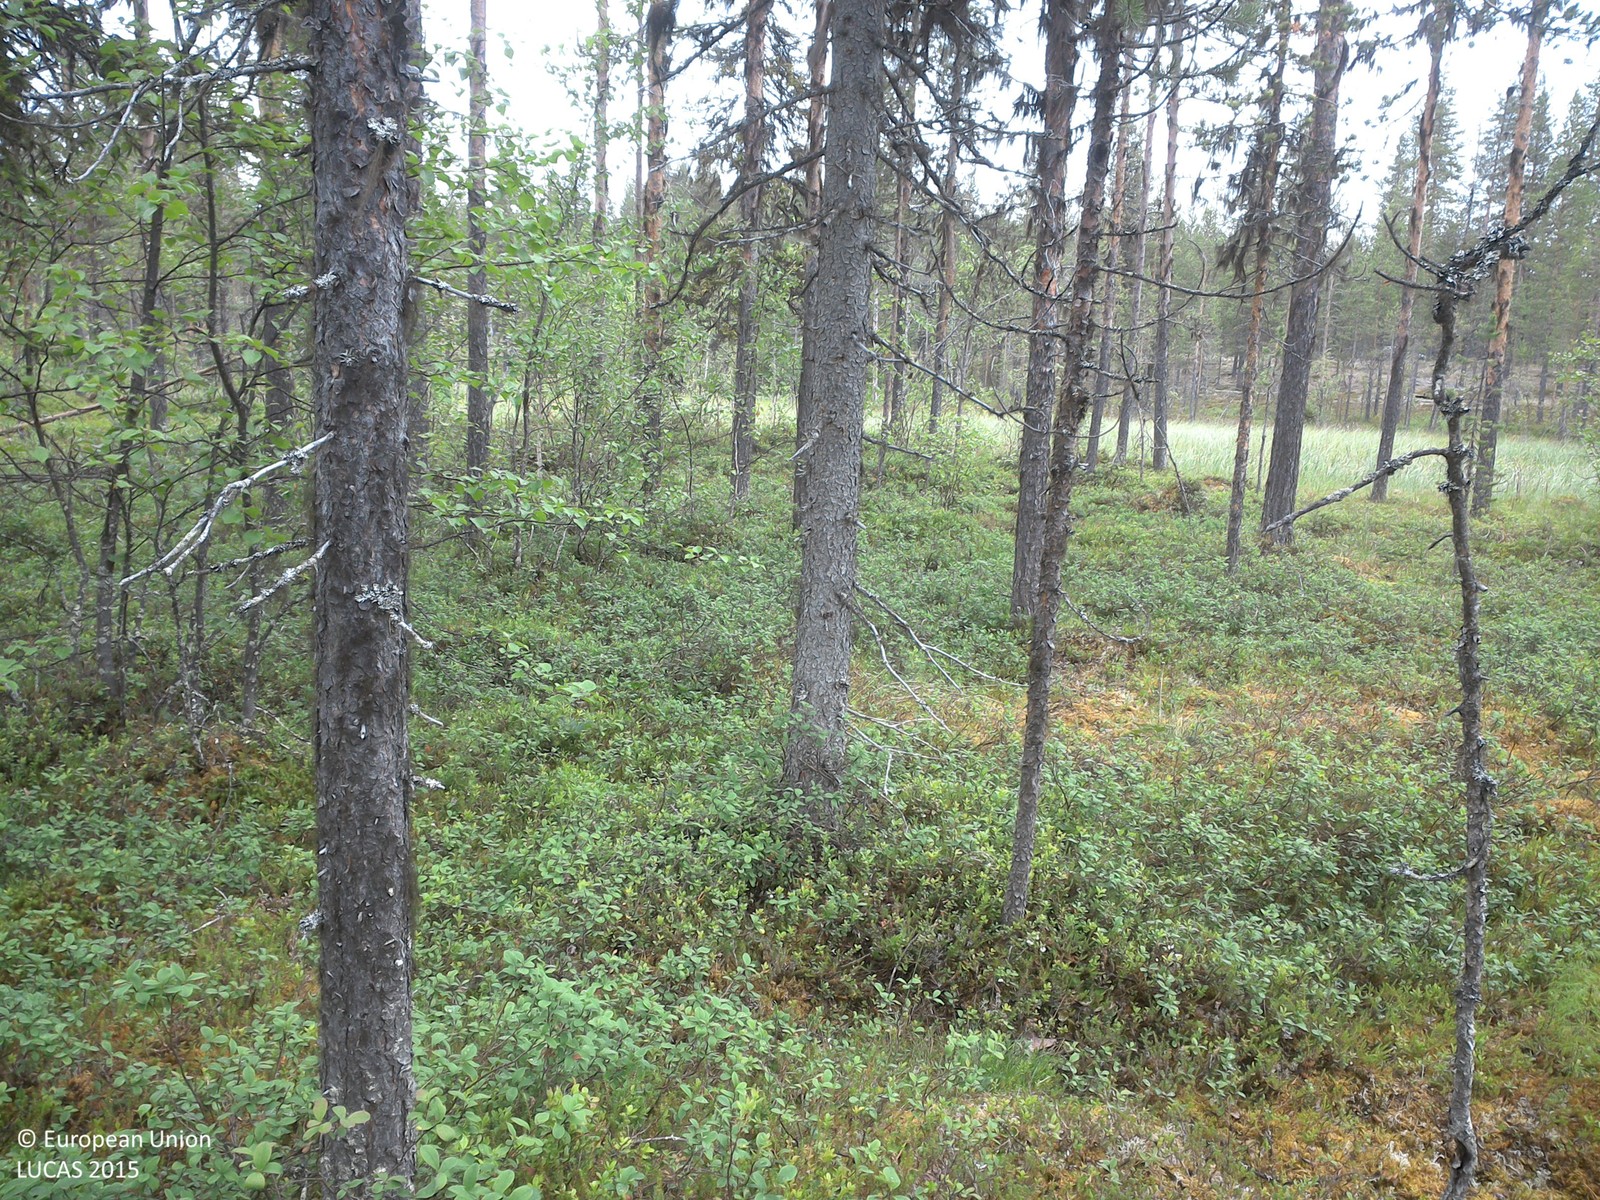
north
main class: Woodland
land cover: Pine dominated mixed woodland
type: boreal forest
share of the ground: 10 - 25 %
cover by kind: shrubs 70 %, coniferous forest trees 15 %, lichens and mosses 10 %, broadleaved forest trees 5 %
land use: Forestry
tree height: > 5 m
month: July
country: SE
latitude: 67.5364
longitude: 22.2676
